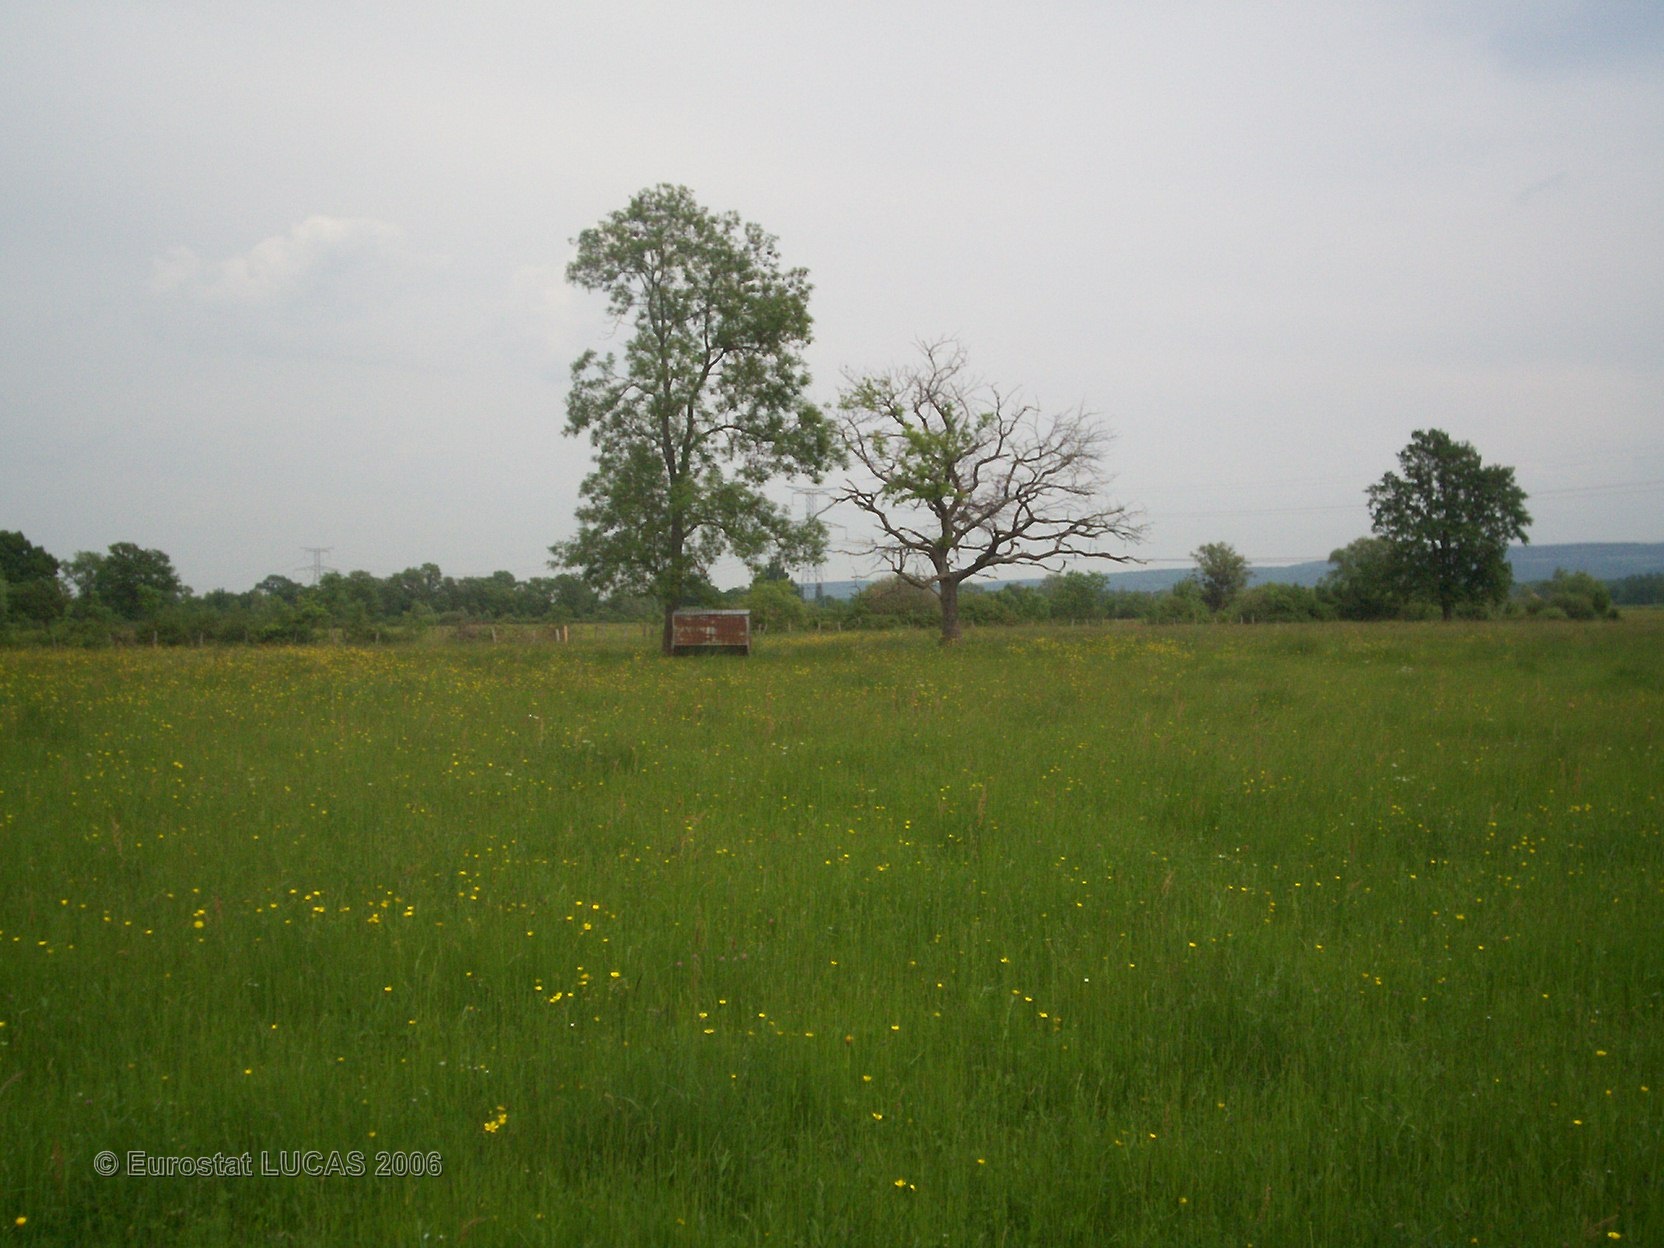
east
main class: Grassland
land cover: Grassland without tree/shrub cover
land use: Agriculture (excluding fallow land and kitchen gardens)
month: May
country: FR
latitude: 46.6367
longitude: 4.7370
